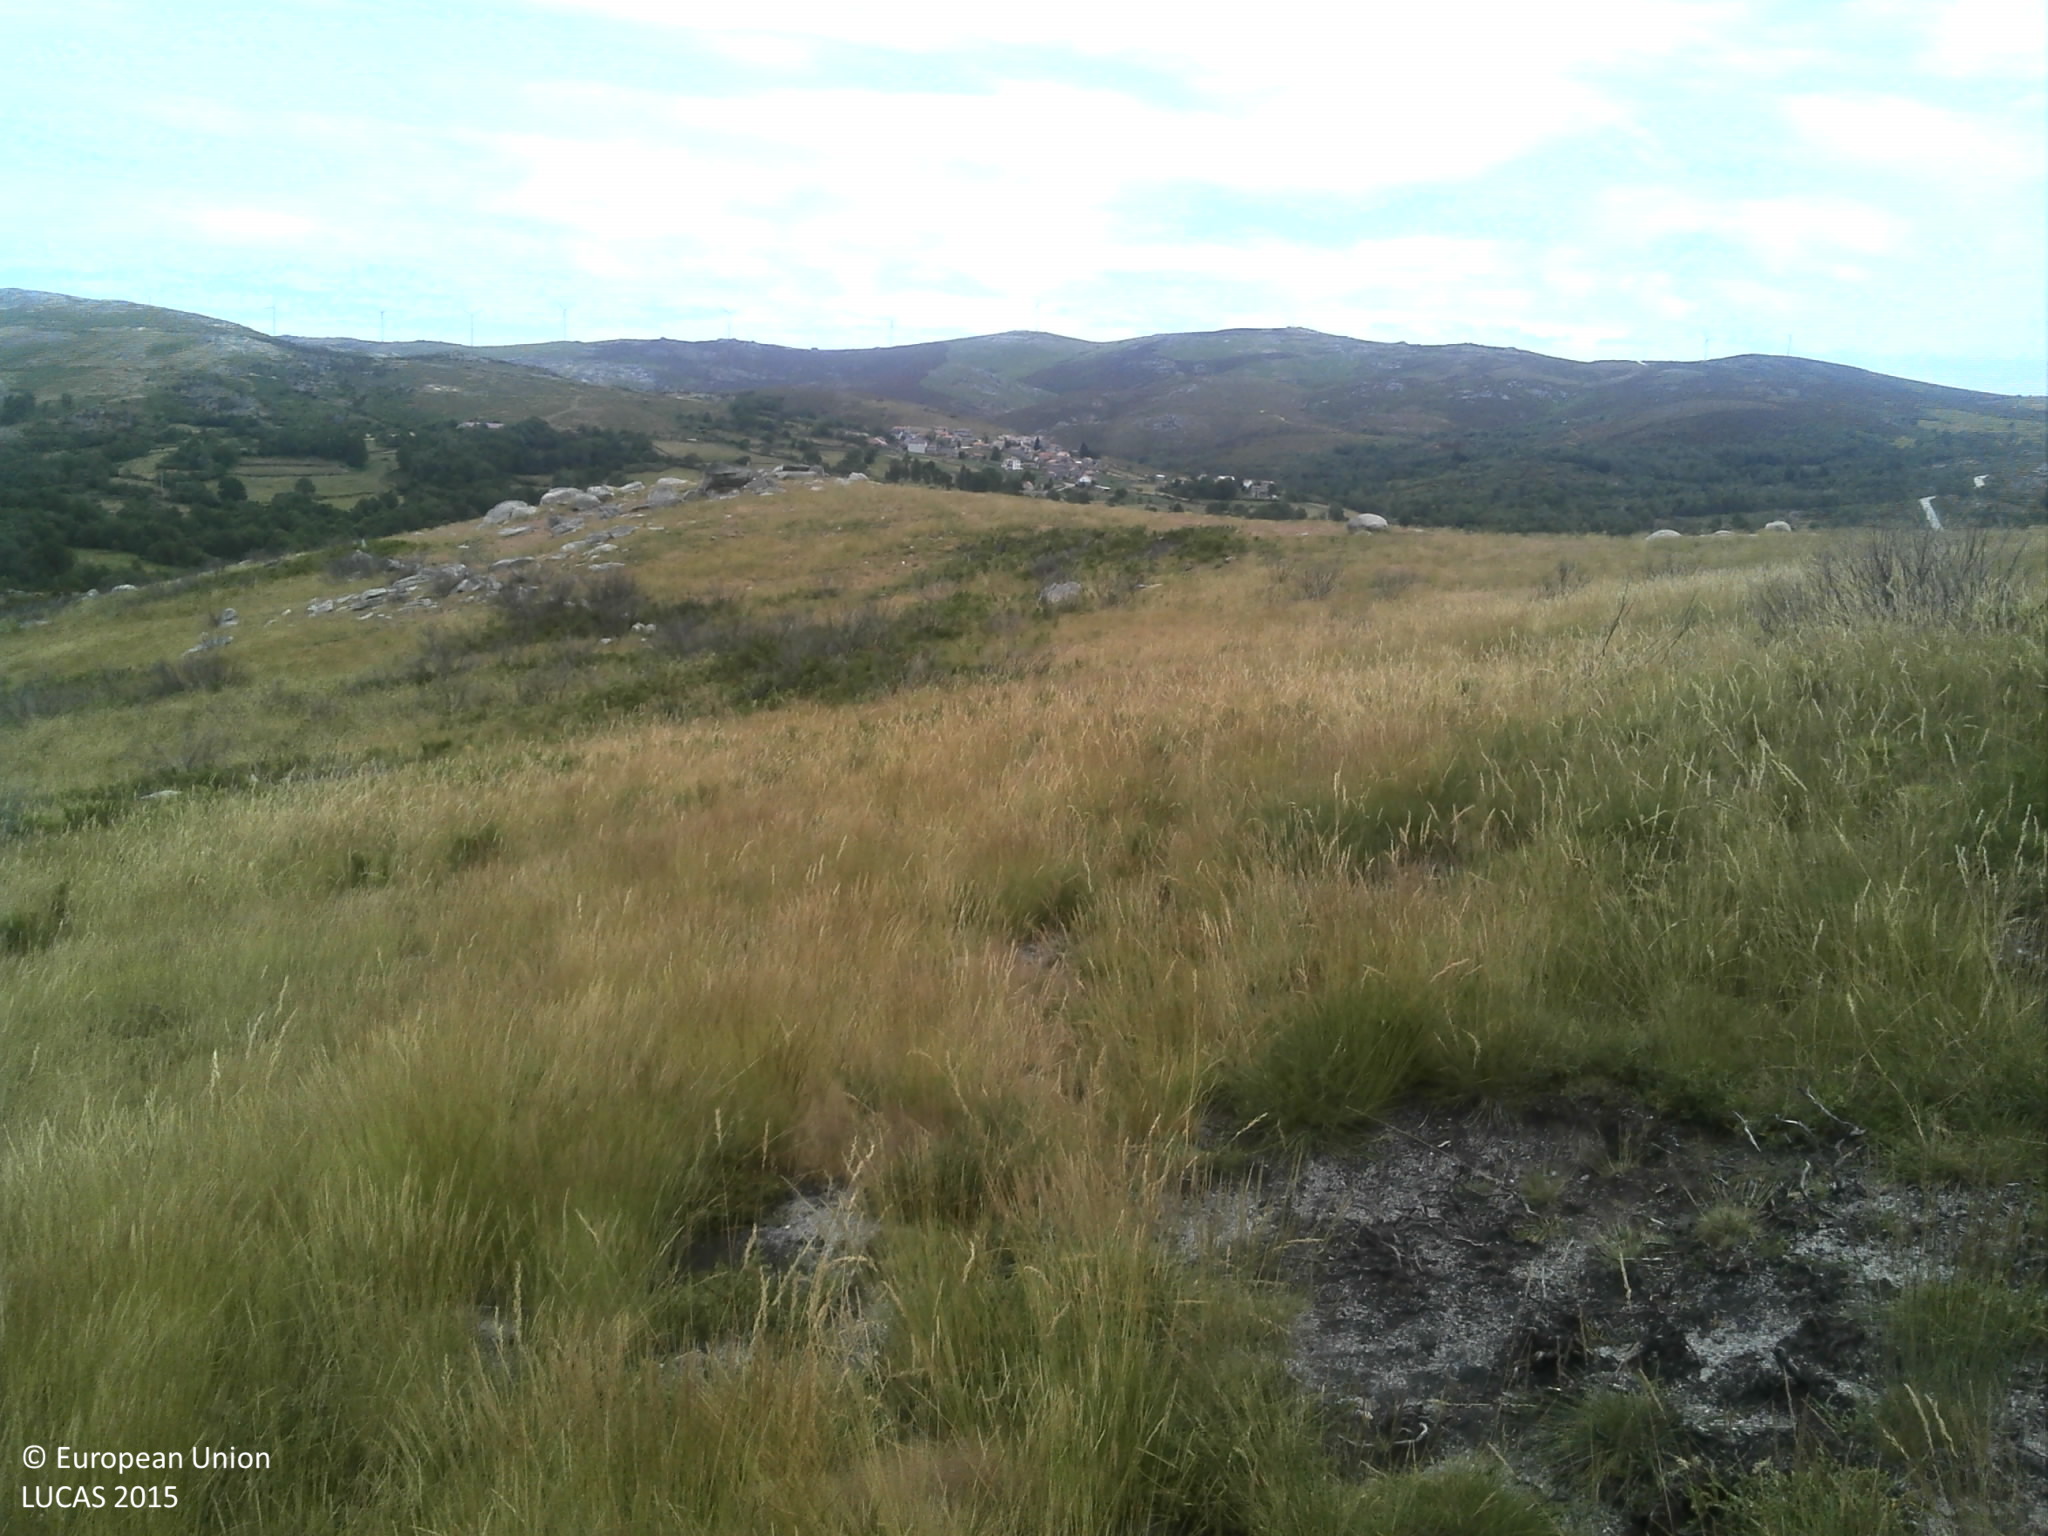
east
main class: Grassland
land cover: Grassland without tree/shrub cover
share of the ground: > 75 %
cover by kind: herbaceous plants 80 %, consolidated bare surface 10 %, shrubs 5 %, unconsolidated bare surface 5 %
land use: Agriculture (excluding fallow land and kitchen gardens)
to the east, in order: Grassland without tree/shrub cover; Rock outcrops; Grassland without tree/shrub cover; Rock outcrops; Grassland without tree/shrub cover; Rock outcrops
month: July
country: PT
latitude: 41.3729
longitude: -7.8168
